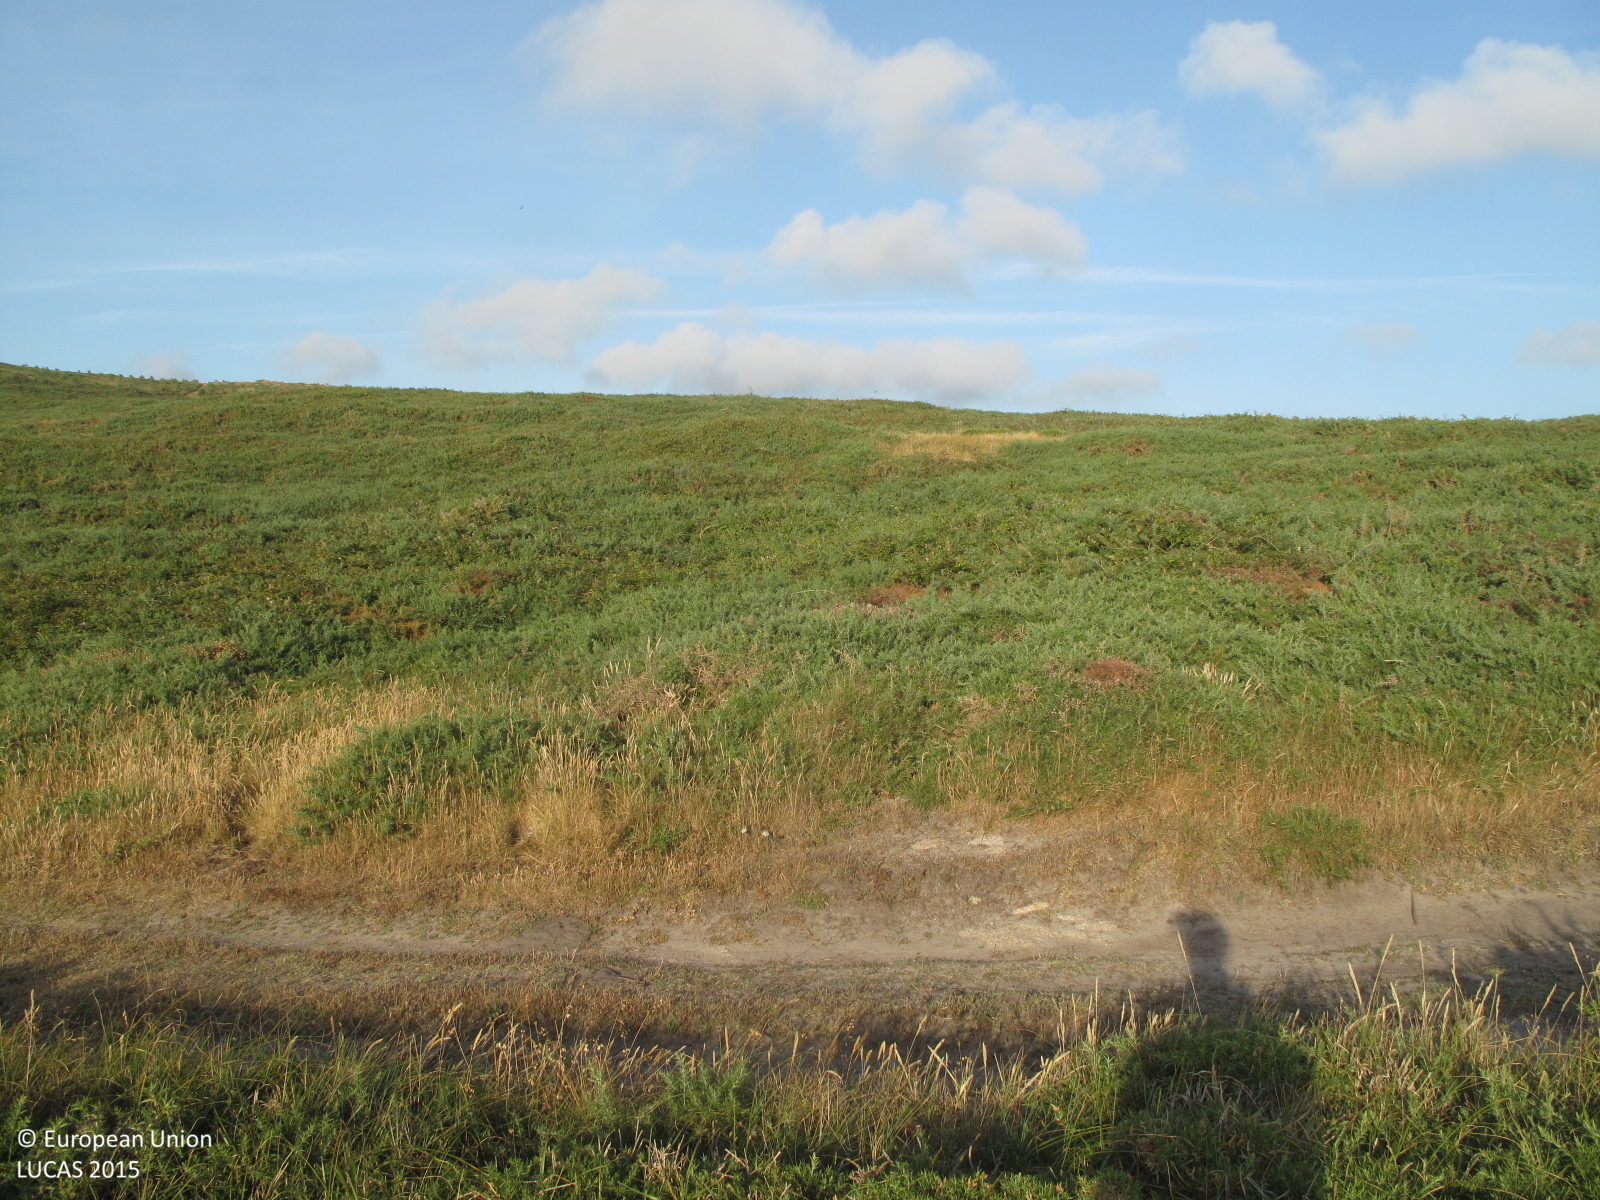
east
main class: Shrubland
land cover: Shrubland without tree cover
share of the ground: > 75 %
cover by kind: shrubs 100 %
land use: Semi-natural and natural areas not in use
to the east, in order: Shrubland without tree cover; Tracks; Shrubland without tree cover; Tracks; Shrubland without tree cover; Tracks; Shrubland without tree cover; Grassland with sparse tree/shrub cover
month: July
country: ES
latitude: 43.5132
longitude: -8.3275
